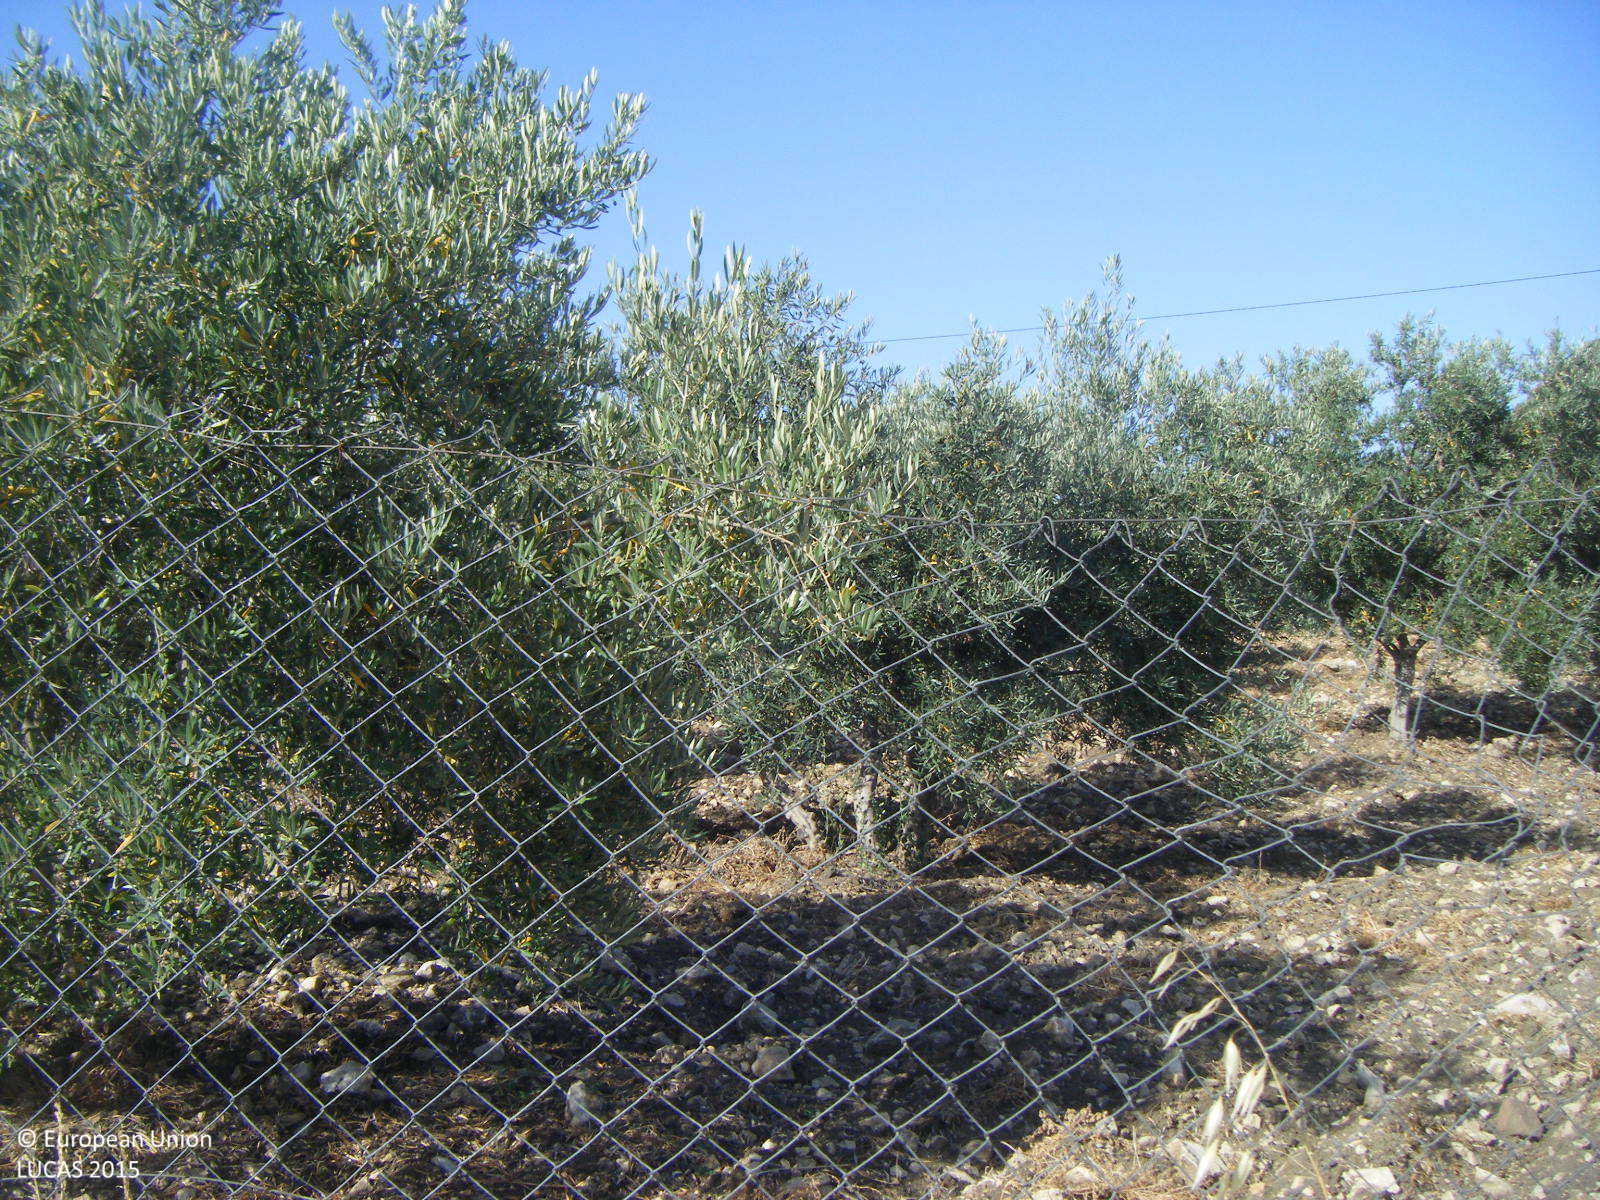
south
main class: Cropland
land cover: Olive groves
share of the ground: 10 - 25 %
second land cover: Spontaneously vegetated surfaces
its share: > 75 %
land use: Agriculture (excluding fallow land and kitchen gardens)
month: July
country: ES
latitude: 36.9431
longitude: -4.3772
